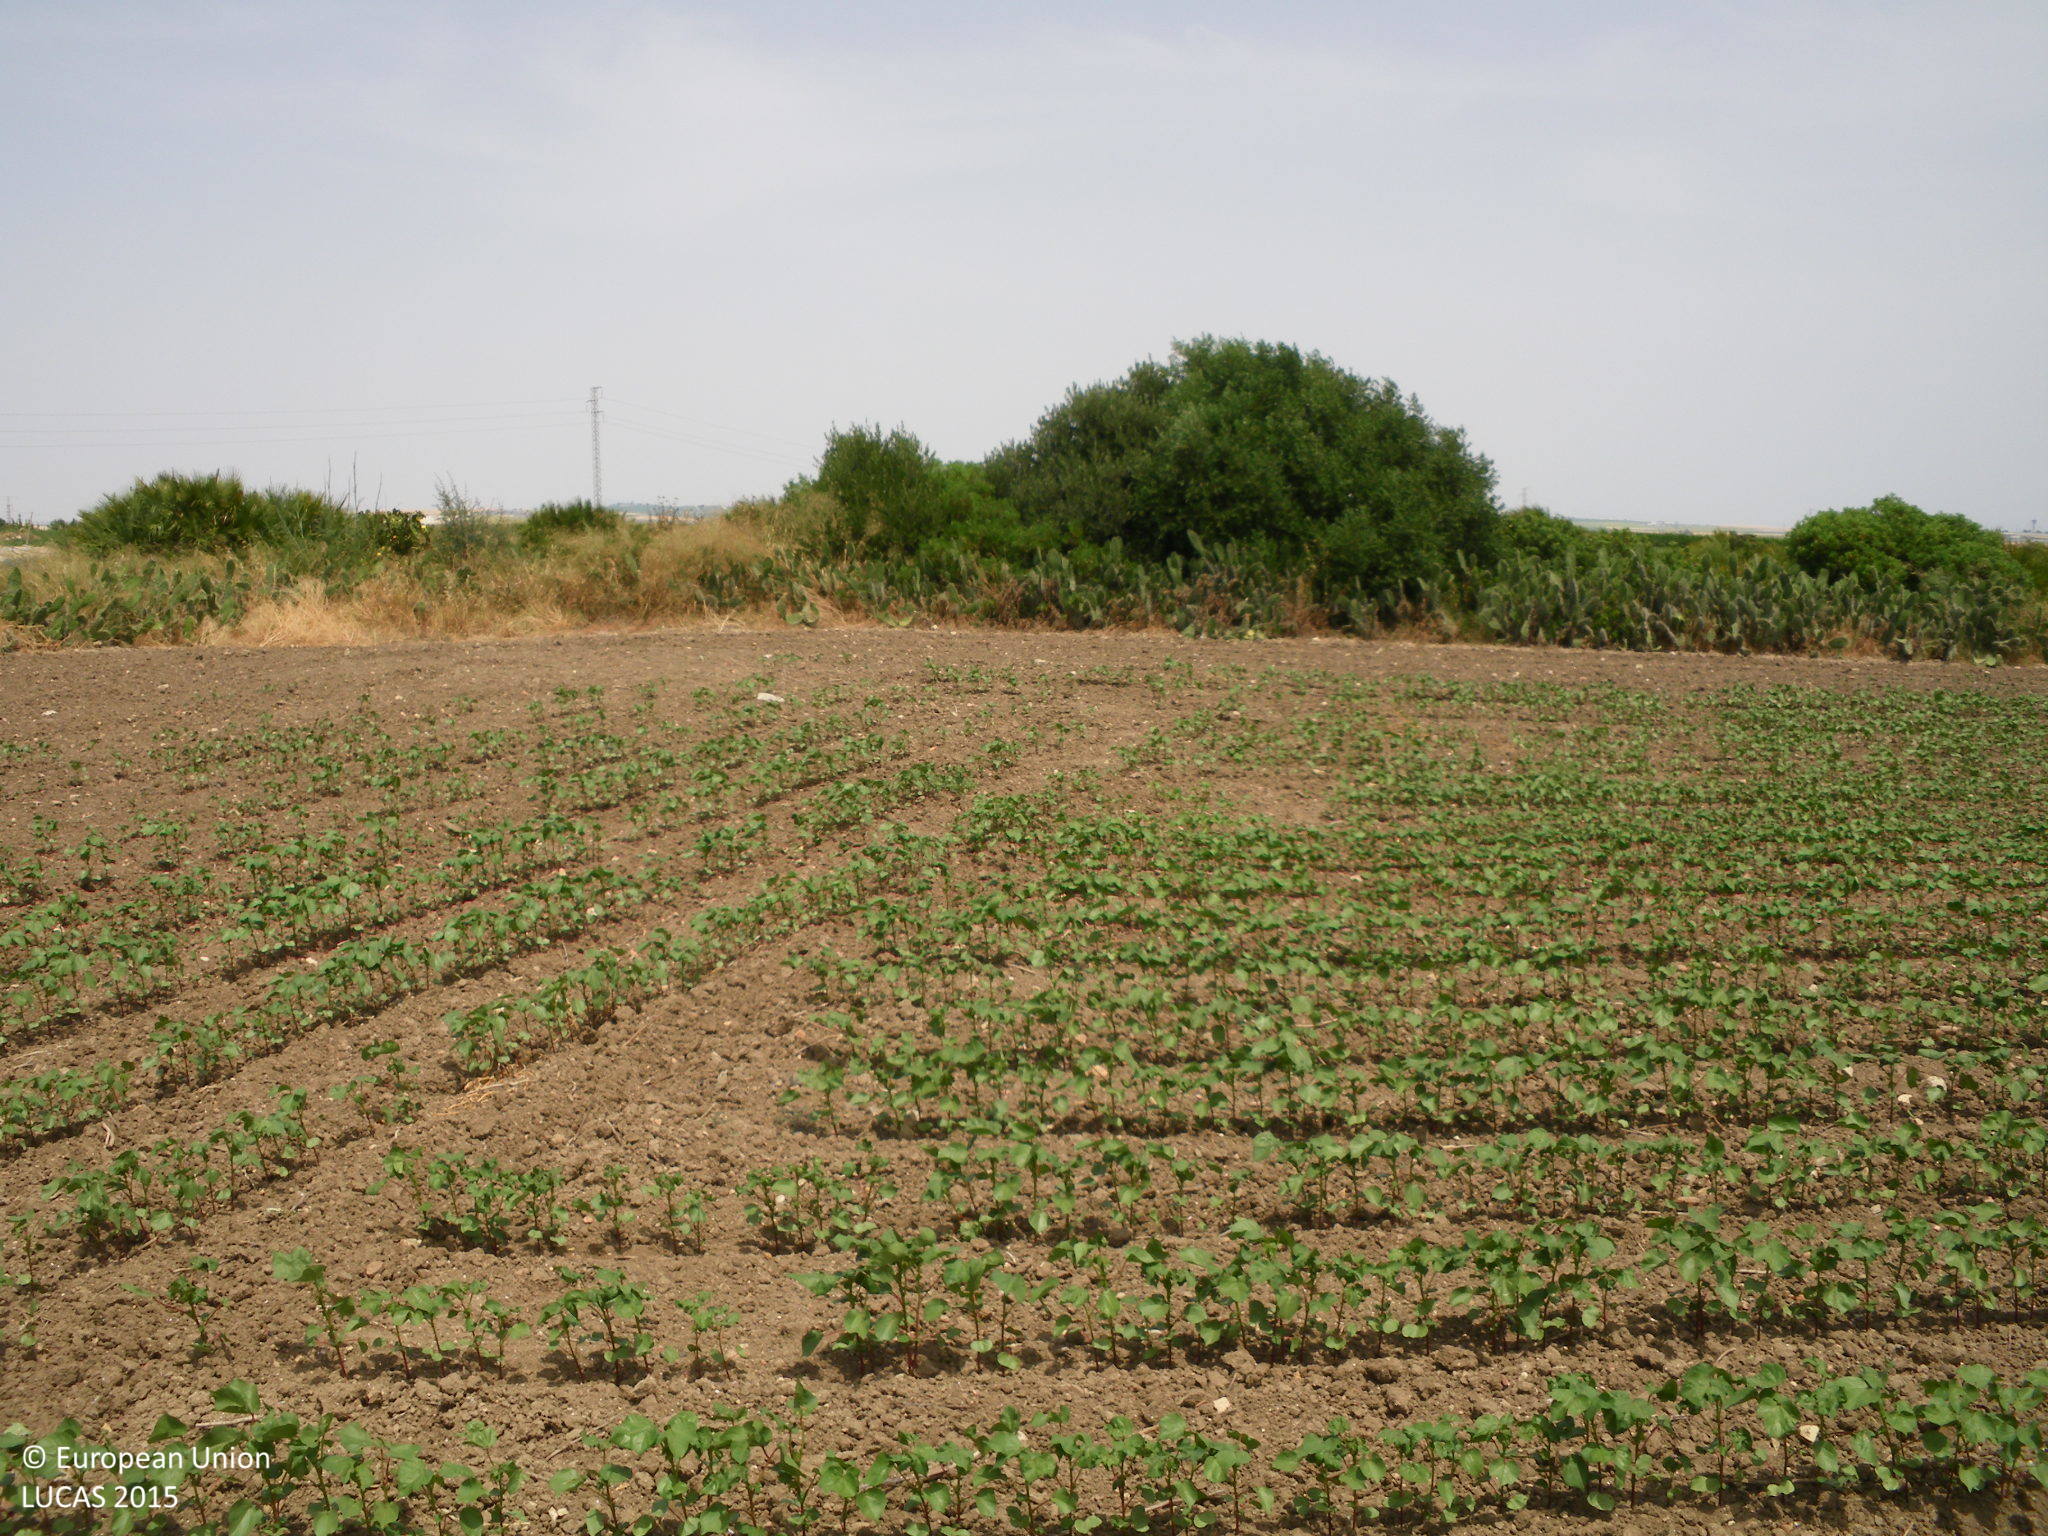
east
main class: Cropland
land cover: Cotton
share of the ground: 10 - 25 %
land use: Agriculture (excluding fallow land and kitchen gardens)
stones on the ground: < 10 %
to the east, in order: Cotton; Shrubland with sparse tree cover; Ditches and canals; Grass margins; Paved roads, cycling and walking lanes; Grass margins; Ditches and canals; Shrubland without tree cover; Cotton; Maize
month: June
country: ES
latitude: 36.6744
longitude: -6.3408
